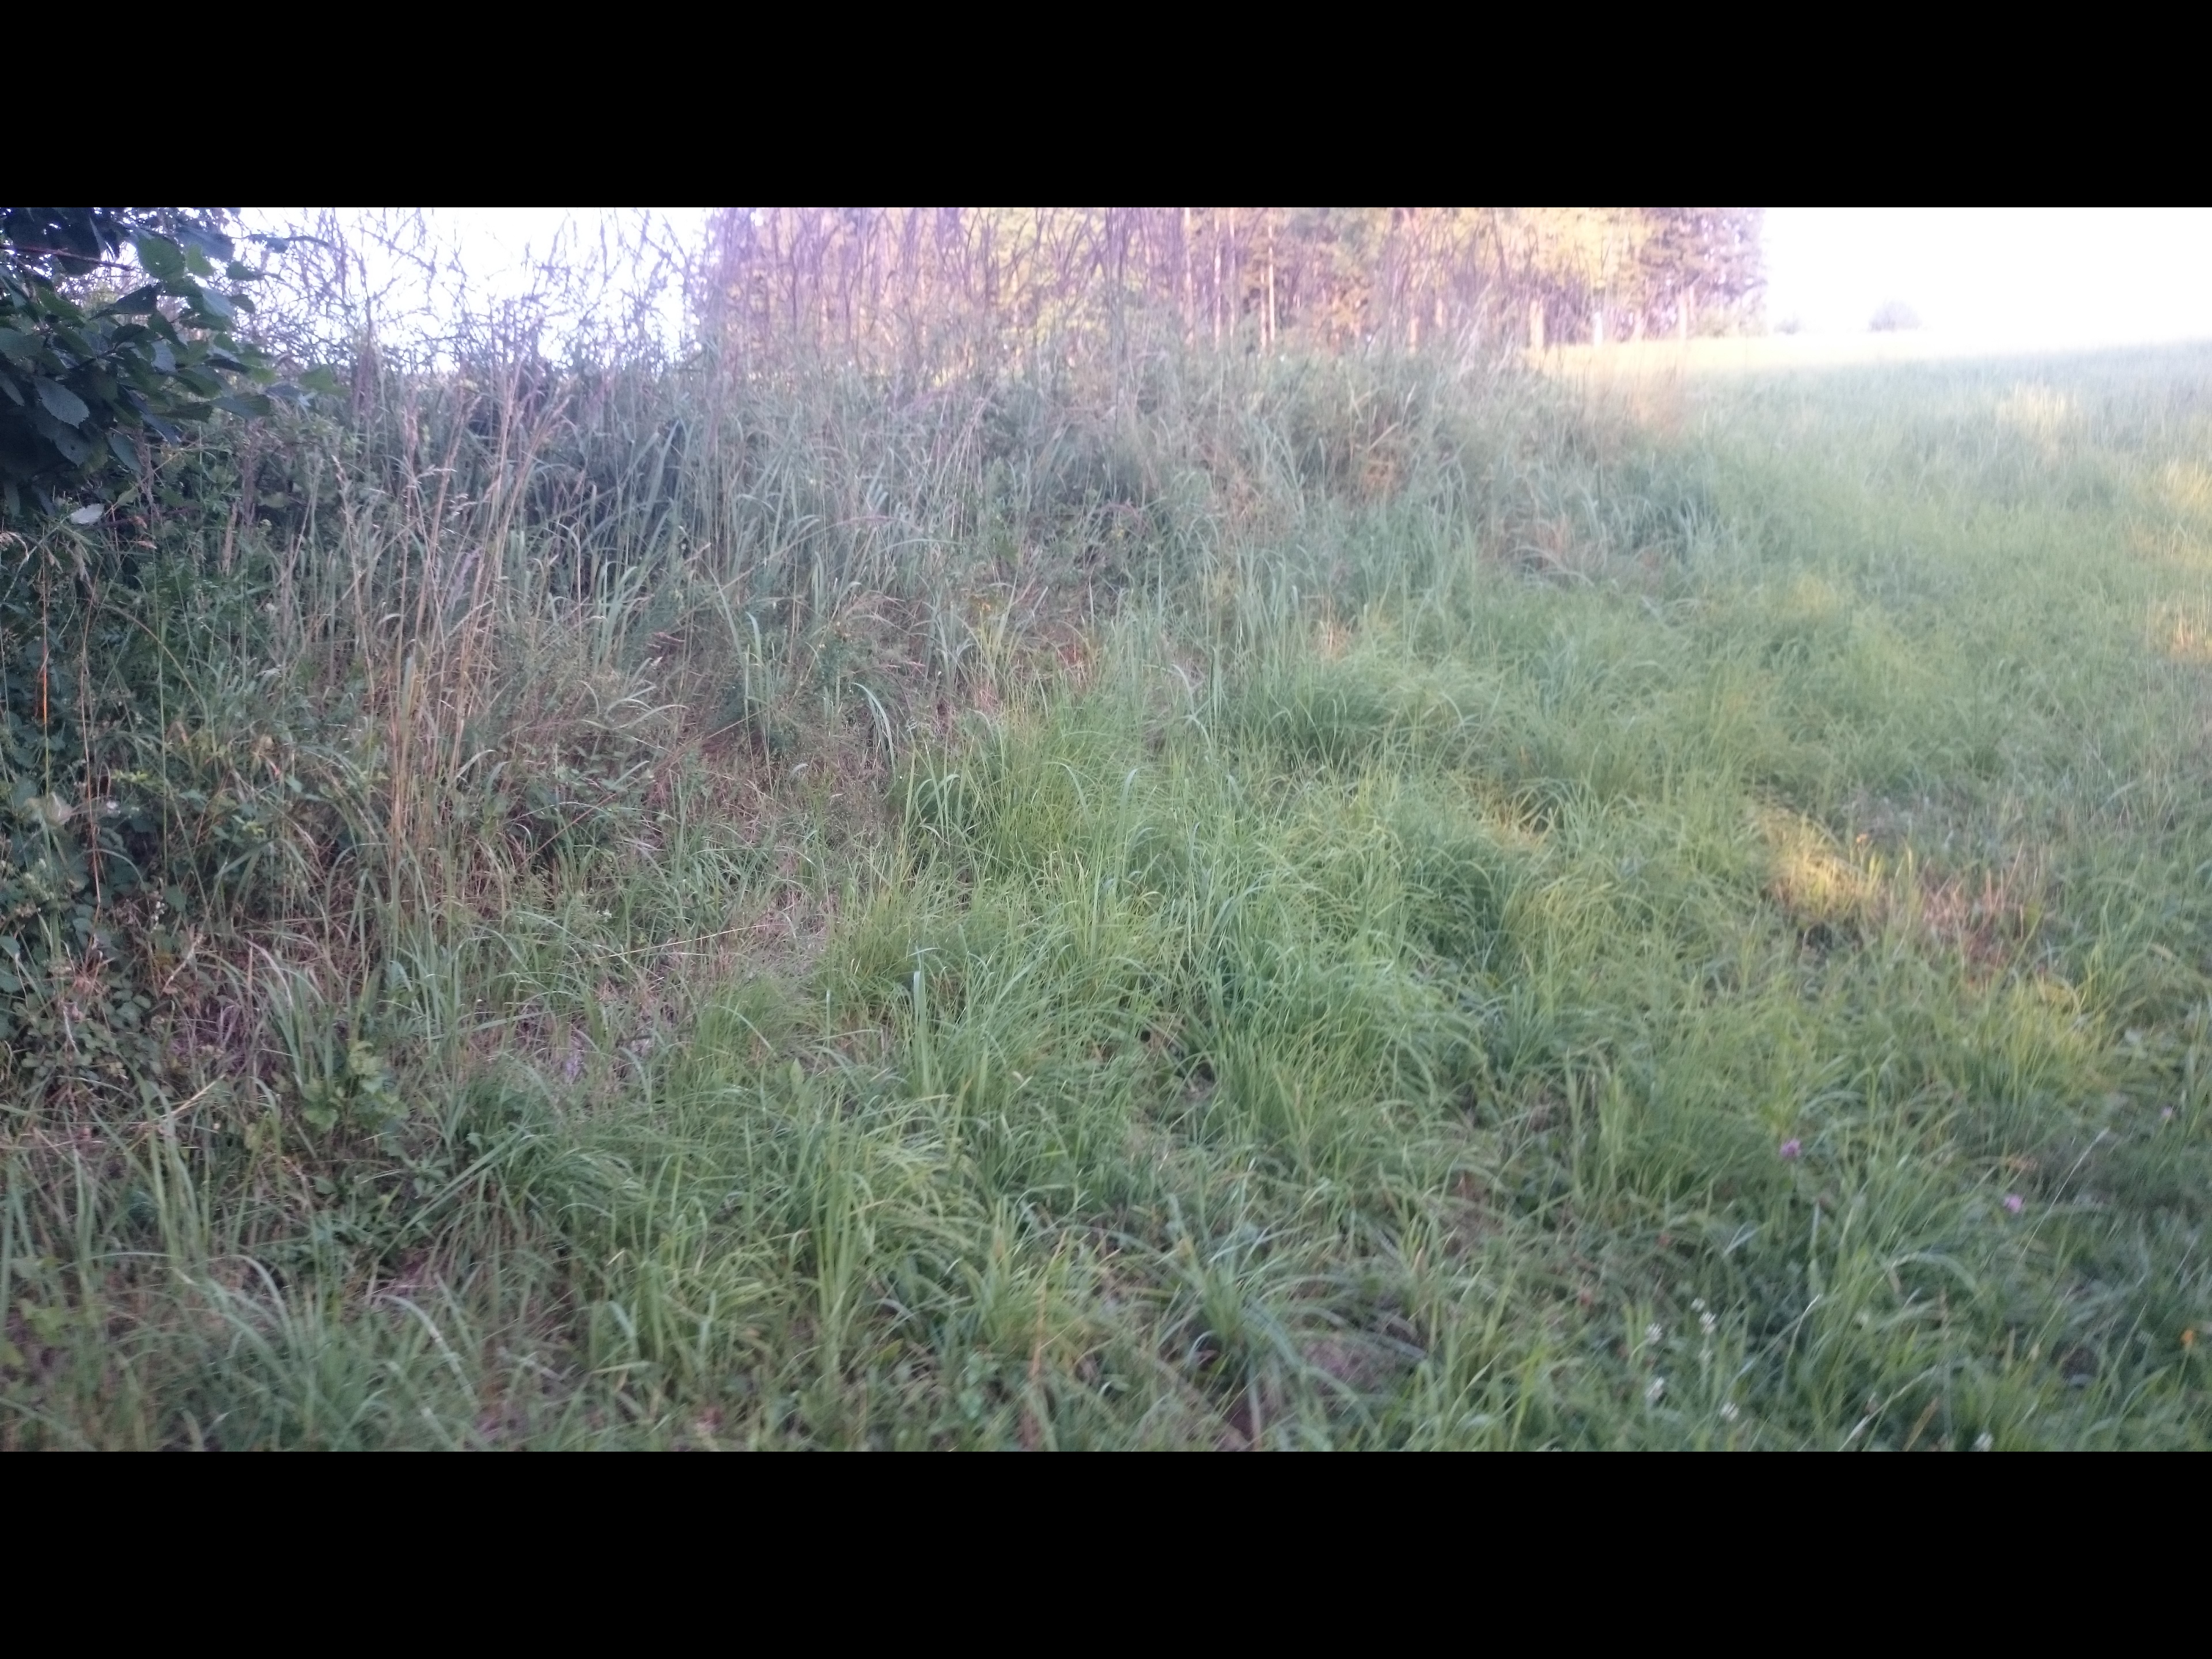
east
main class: Grassland
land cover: Grassland without tree/shrub cover
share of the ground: > 75 %
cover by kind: herbaceous plants 100 %
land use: Agriculture (excluding fallow land and kitchen gardens)
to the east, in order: Grassland without tree/shrub cover; Abandoned hedges; Grassland without tree/shrub cover; Tracks; Potatoes; Grassland without tree/shrub cover; Broadleaved woodland; Rye
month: July
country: AT
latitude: 47.3002
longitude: 15.7010
